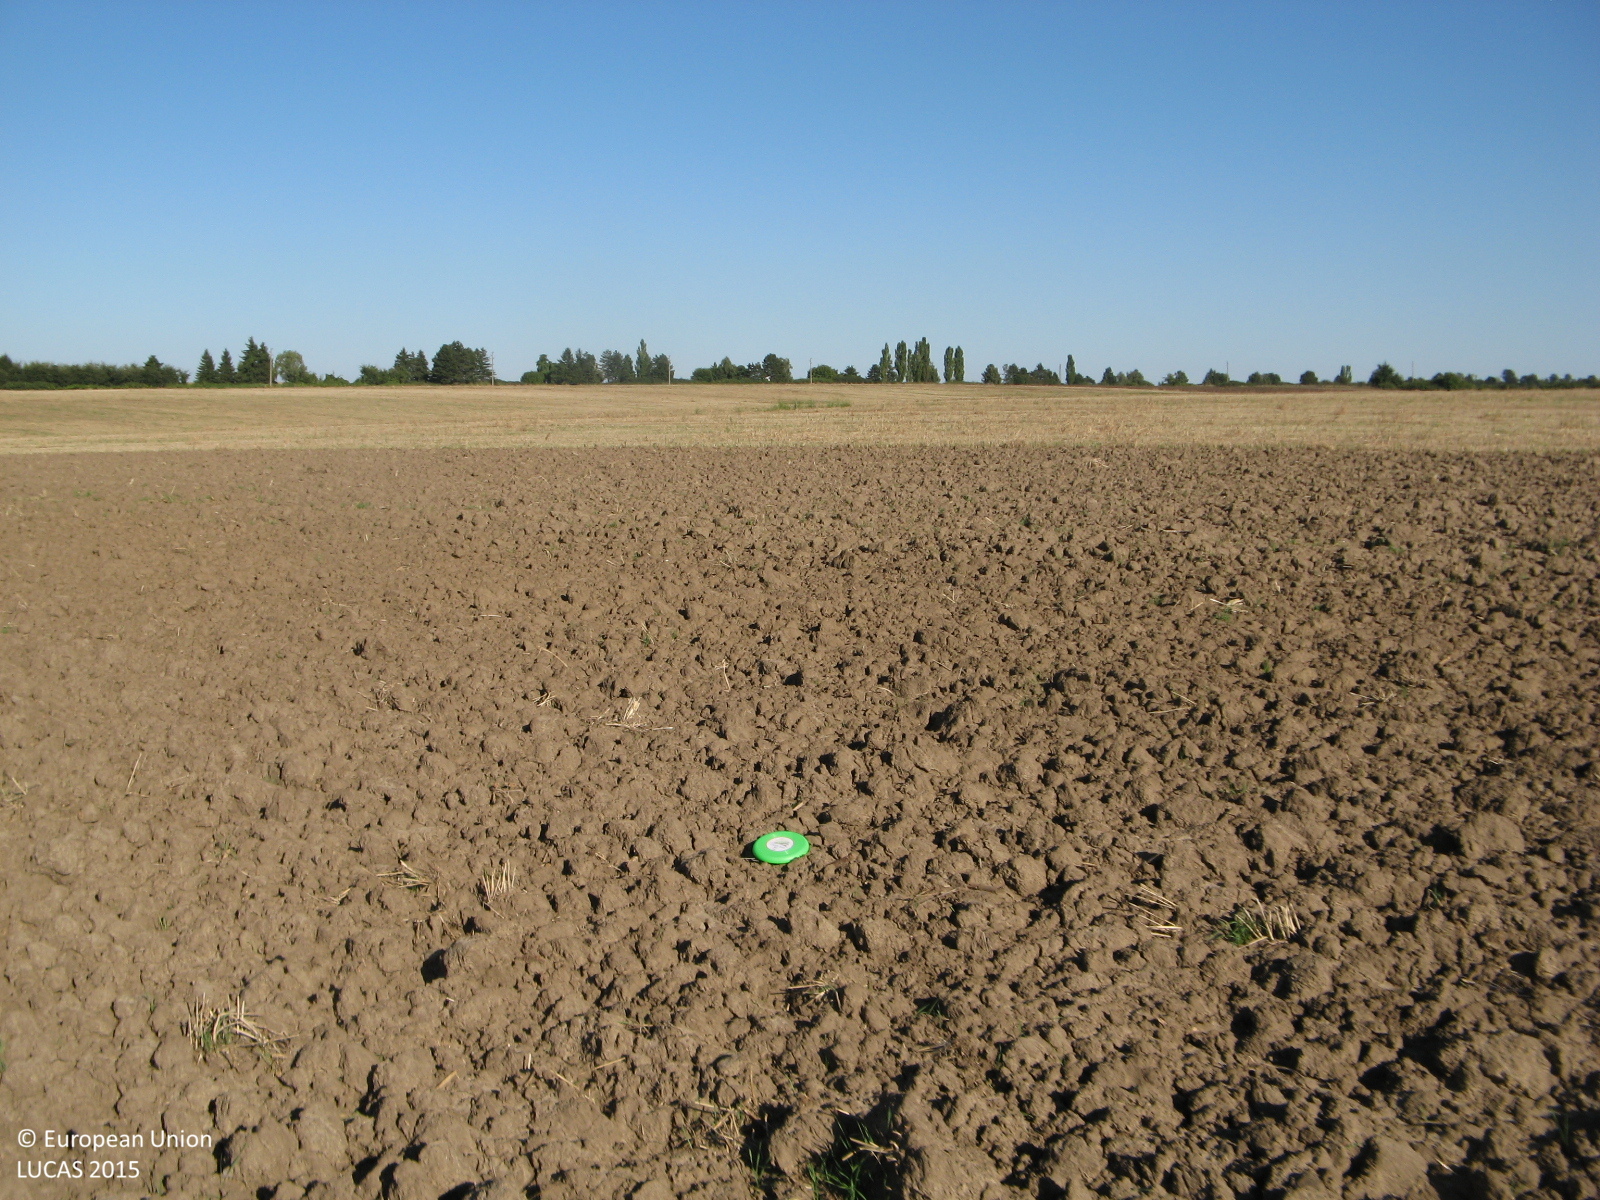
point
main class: Cropland
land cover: Common wheat
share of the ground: < 10 %
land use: Agriculture (excluding fallow land and kitchen gardens)
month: September
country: BG
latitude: 43.7049
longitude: 26.1184
